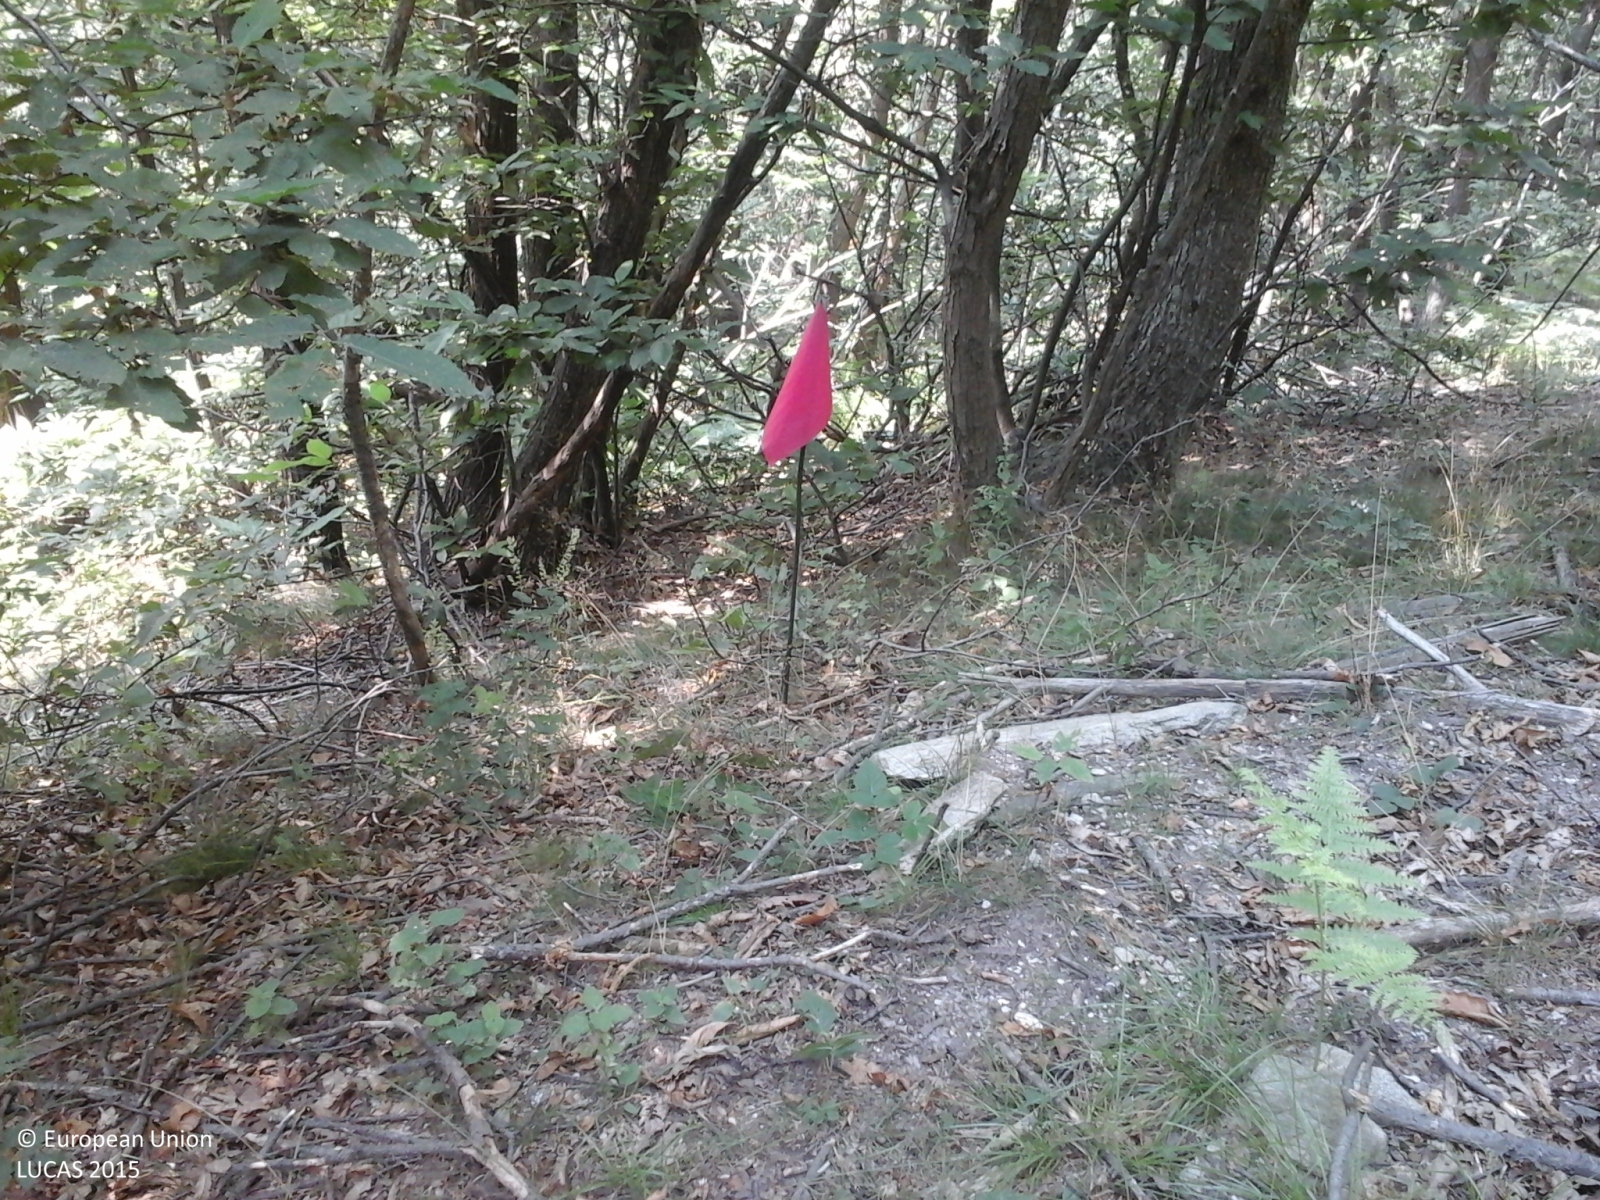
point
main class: Woodland
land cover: Broadleaved woodland
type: thermophilous deciduous forest
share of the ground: > 75 %
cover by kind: broadleaved forest trees 100 %
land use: Forestry
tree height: > 5 m
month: July
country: IT
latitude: 44.7829
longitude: 7.2373
